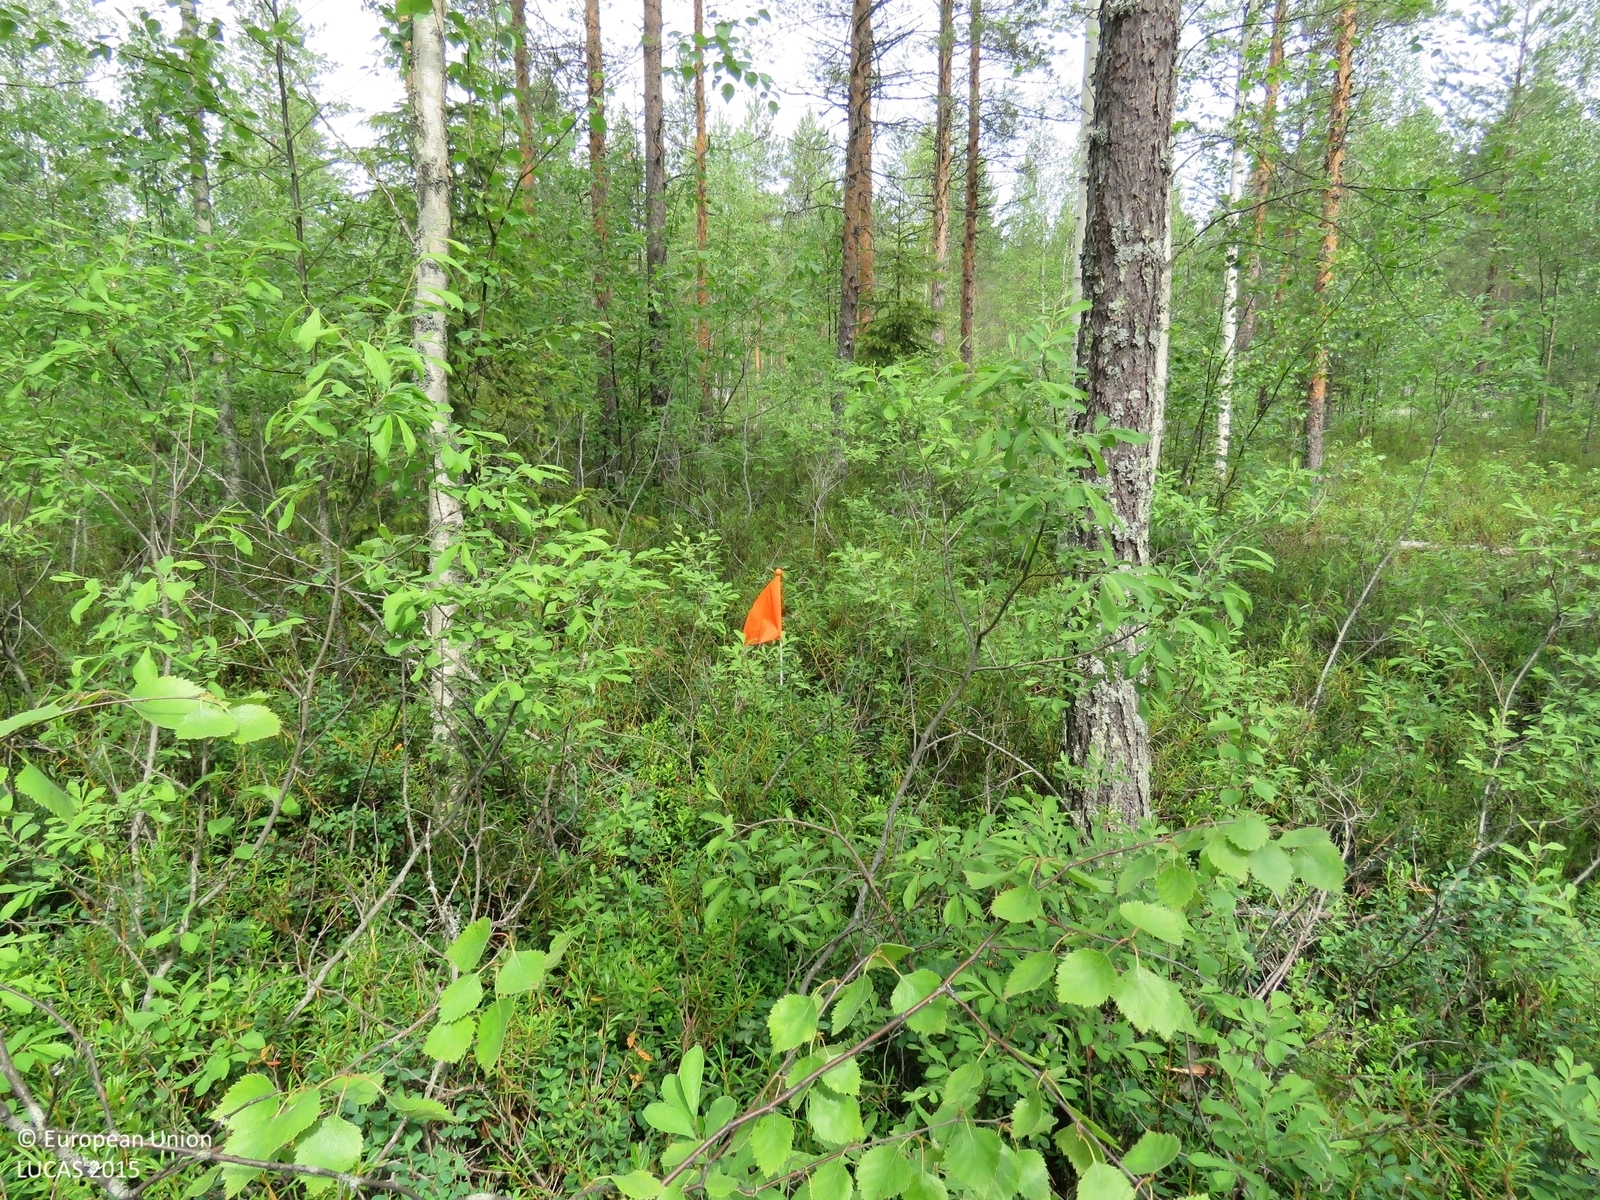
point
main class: Woodland
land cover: Pine dominated mixed woodland
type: boreal forest
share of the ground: > 75 %
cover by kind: coniferous forest trees 50 %, broadleaved forest trees 30 %, shrubs 20 %
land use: Forestry
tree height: > 5 m
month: July
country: FI
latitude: 64.2206
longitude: 26.5865
